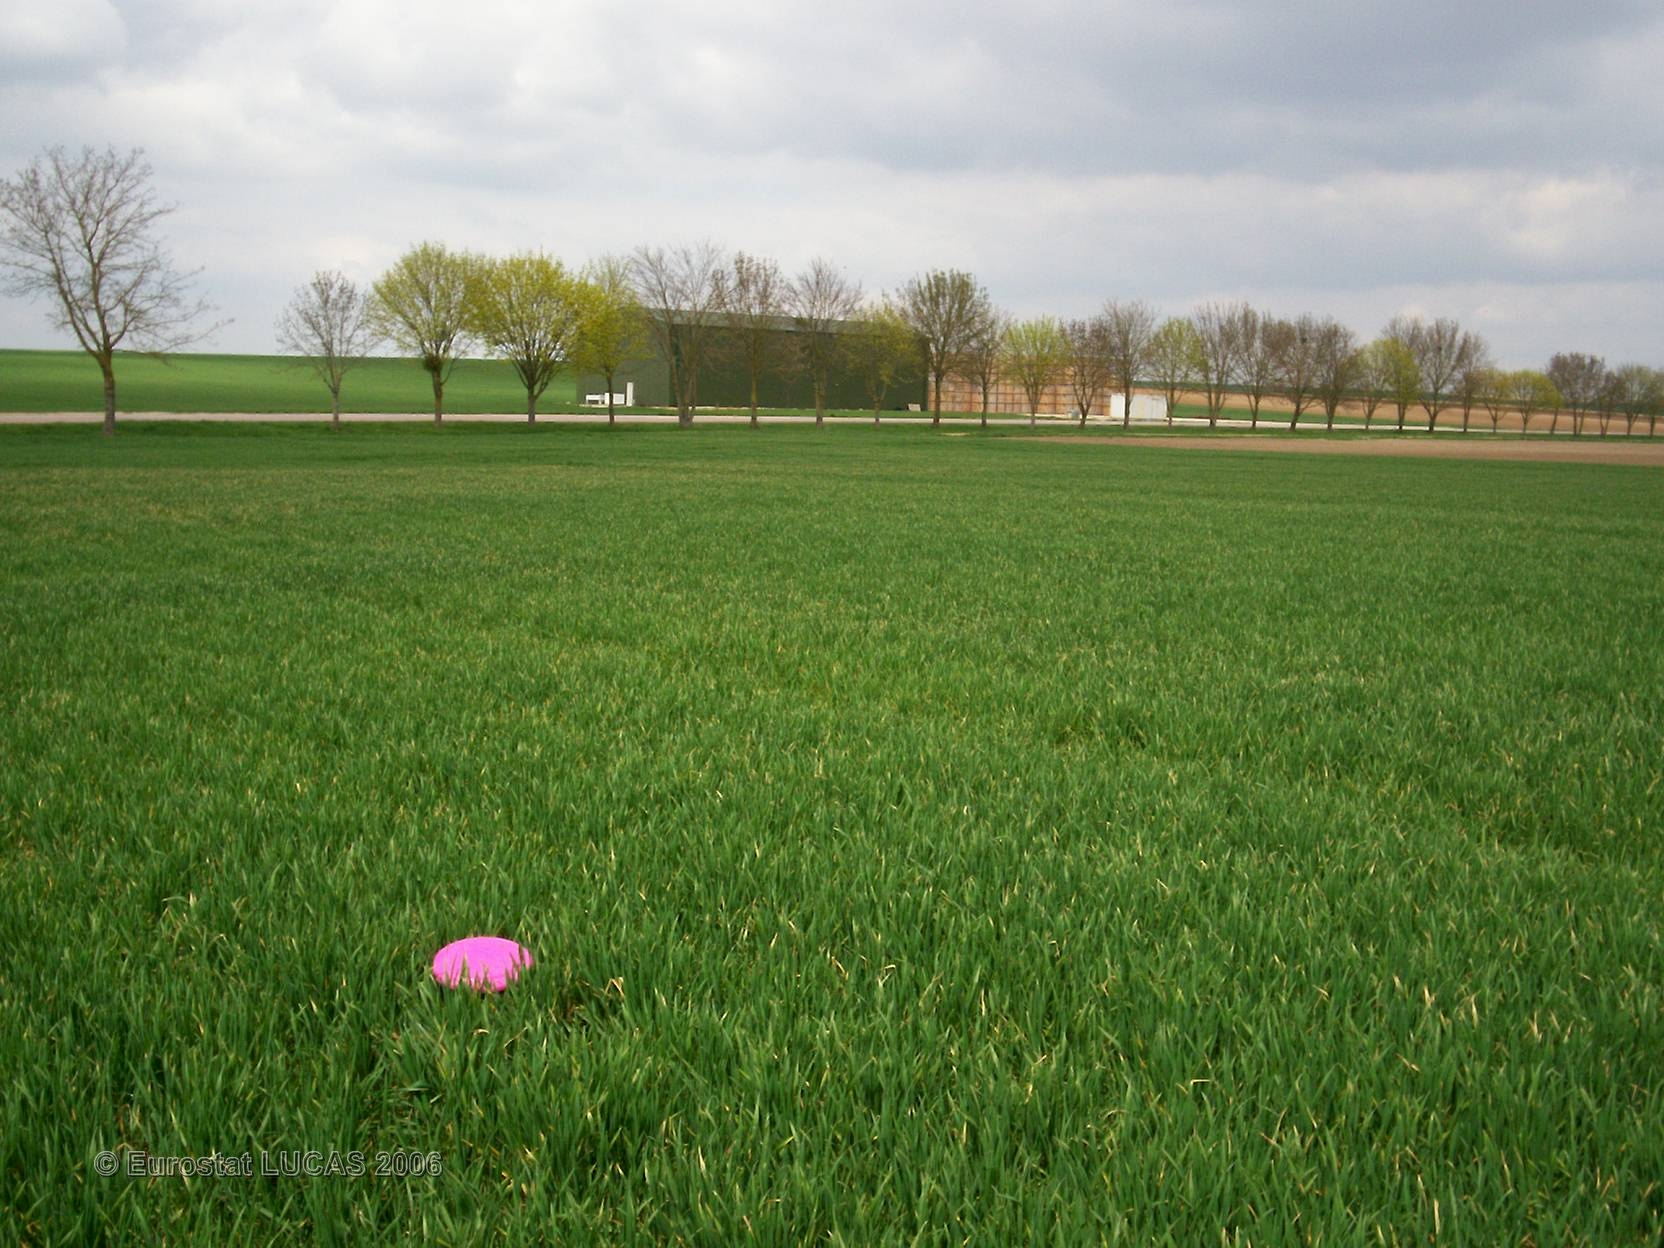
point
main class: Cropland
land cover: Common wheat
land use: Agriculture (excluding fallow land and kitchen gardens)
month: April
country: FR
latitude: 48.5005
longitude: 4.4889
